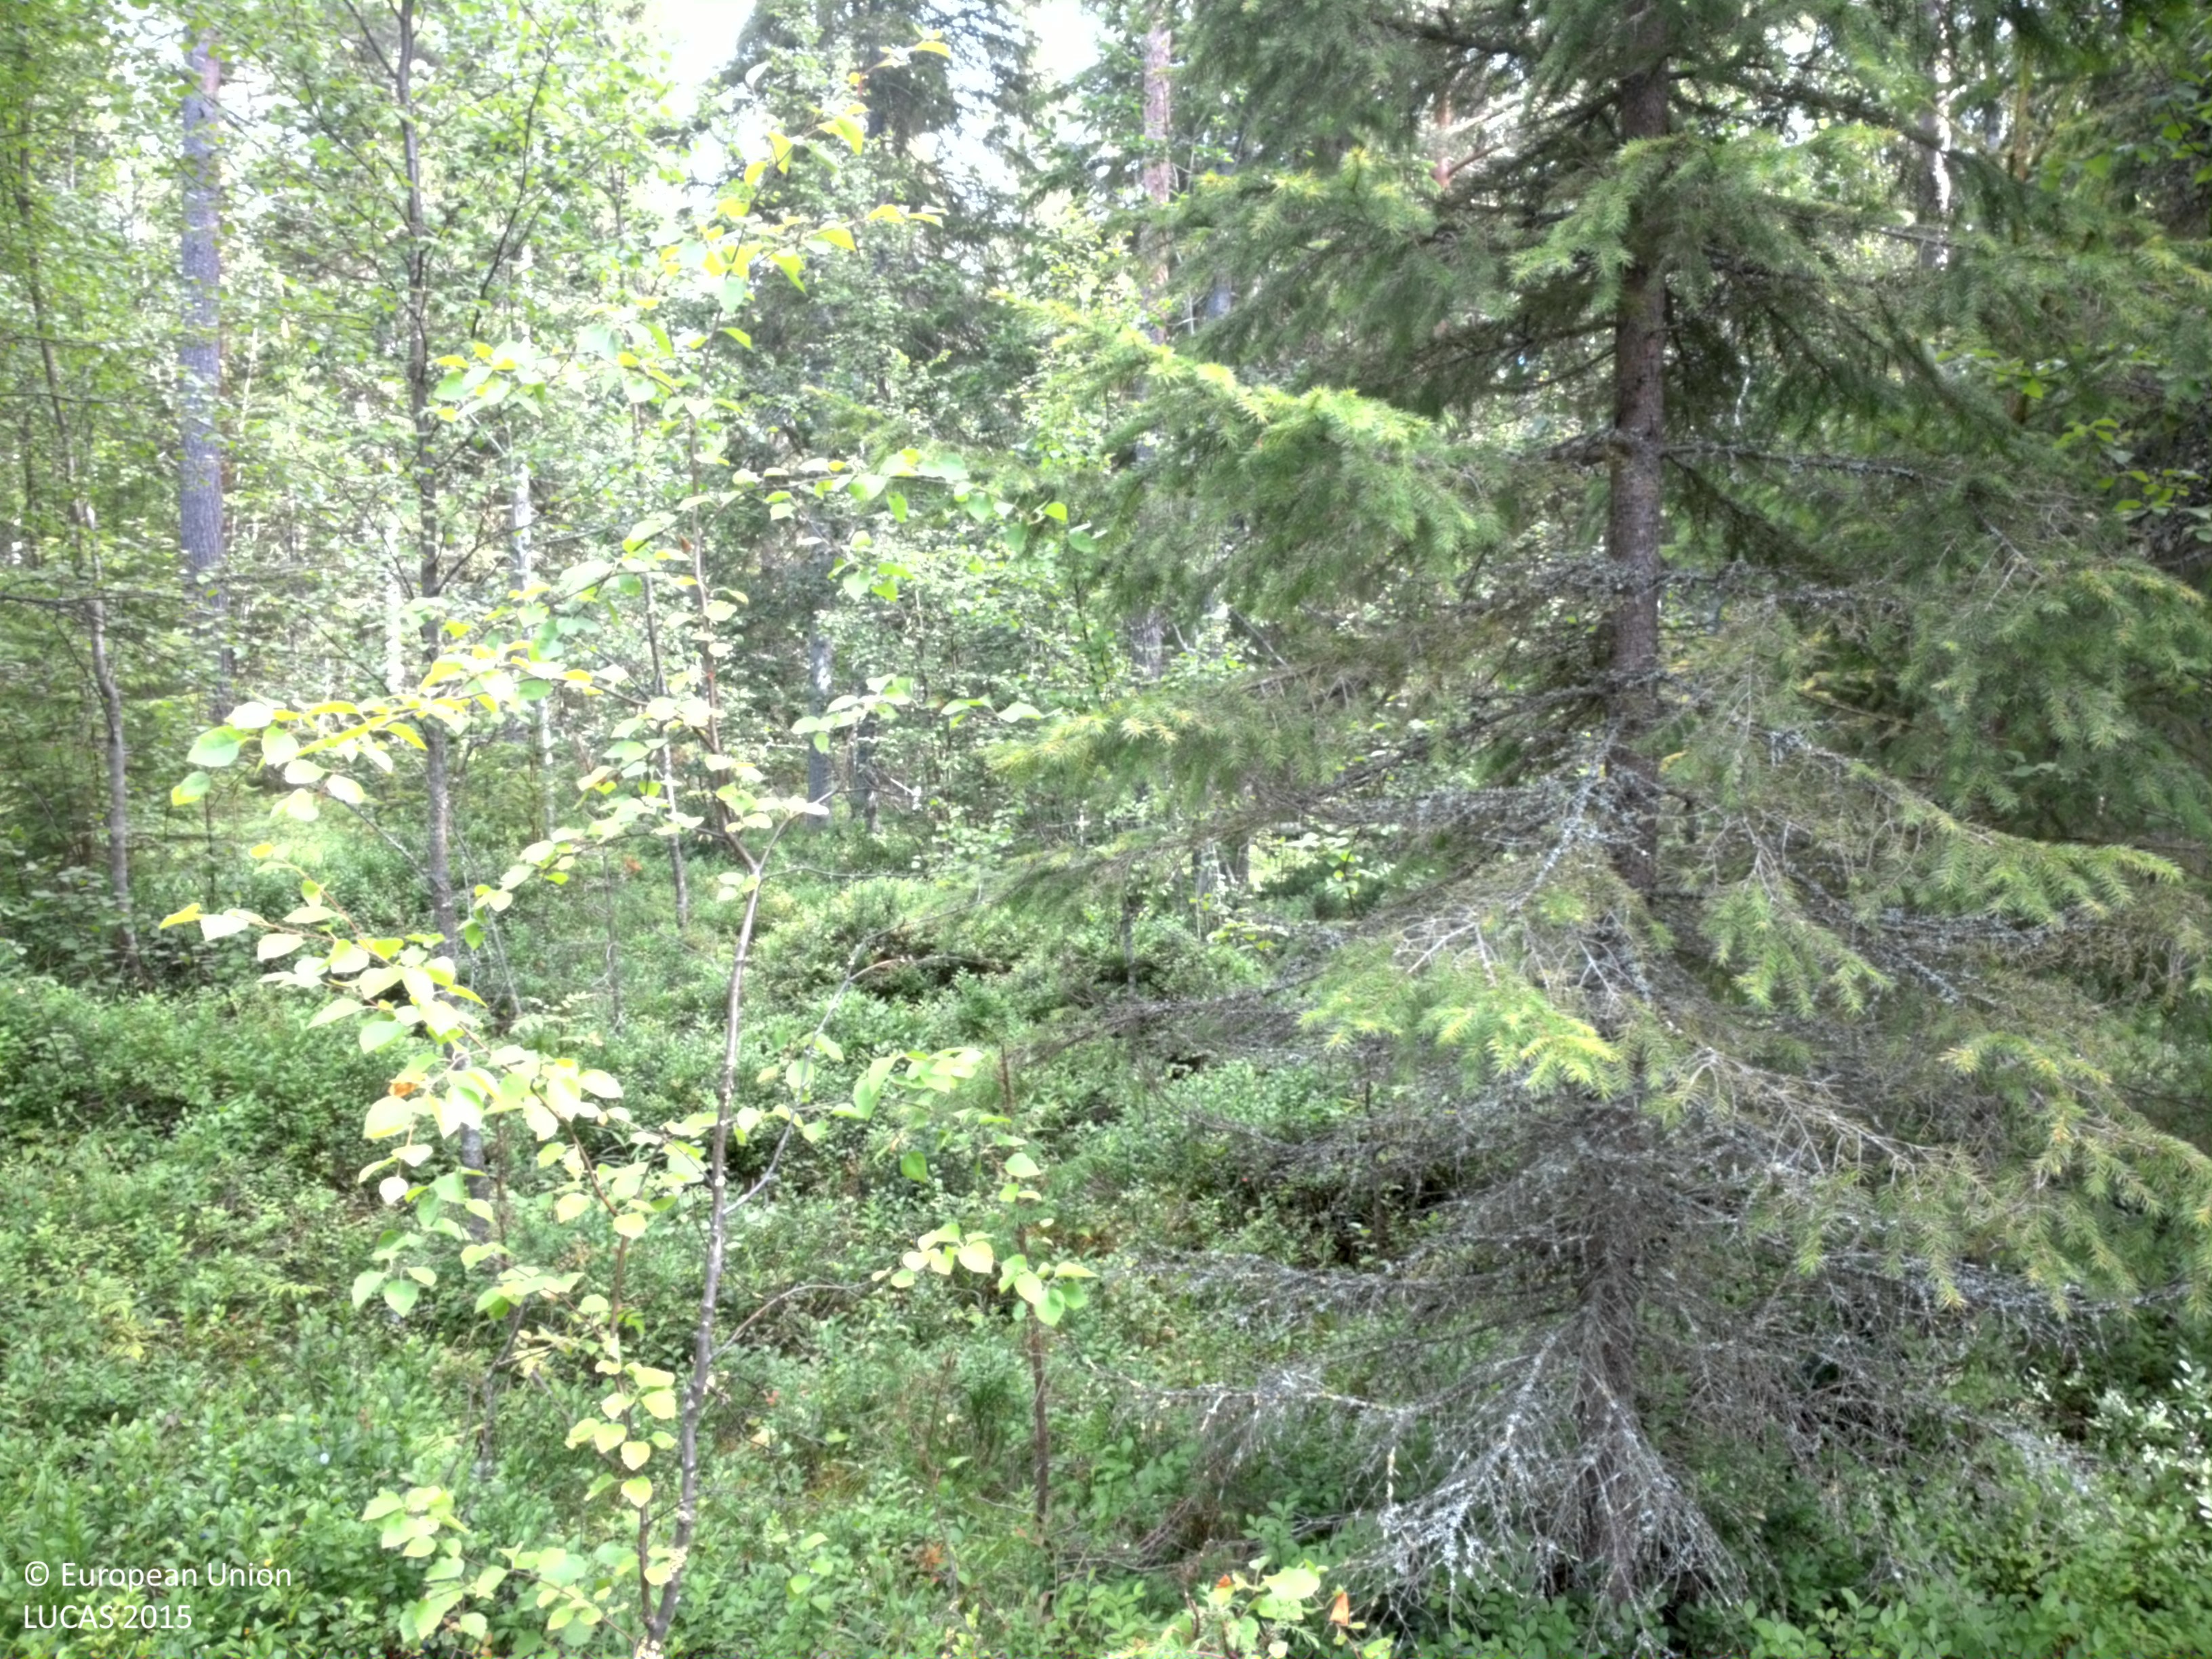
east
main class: Woodland
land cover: Other mixed woodland
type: boreal forest
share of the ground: 50 - 75 %
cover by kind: coniferous forest trees 45 %, shrubs 40 %, broadleaved forest trees 15 %
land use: Forestry
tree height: > 5 m
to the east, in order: Other mixed woodland; Pine dominated mixed woodland; Pine dominated coniferous woodland; Pine dominated mixed woodland; Broadleaved woodland; Ditches and canals; Other mixed woodland; Paved roads, cycling and walking lanes; Other mixed woodland
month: August
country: SE
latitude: 64.6263
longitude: 20.8754
